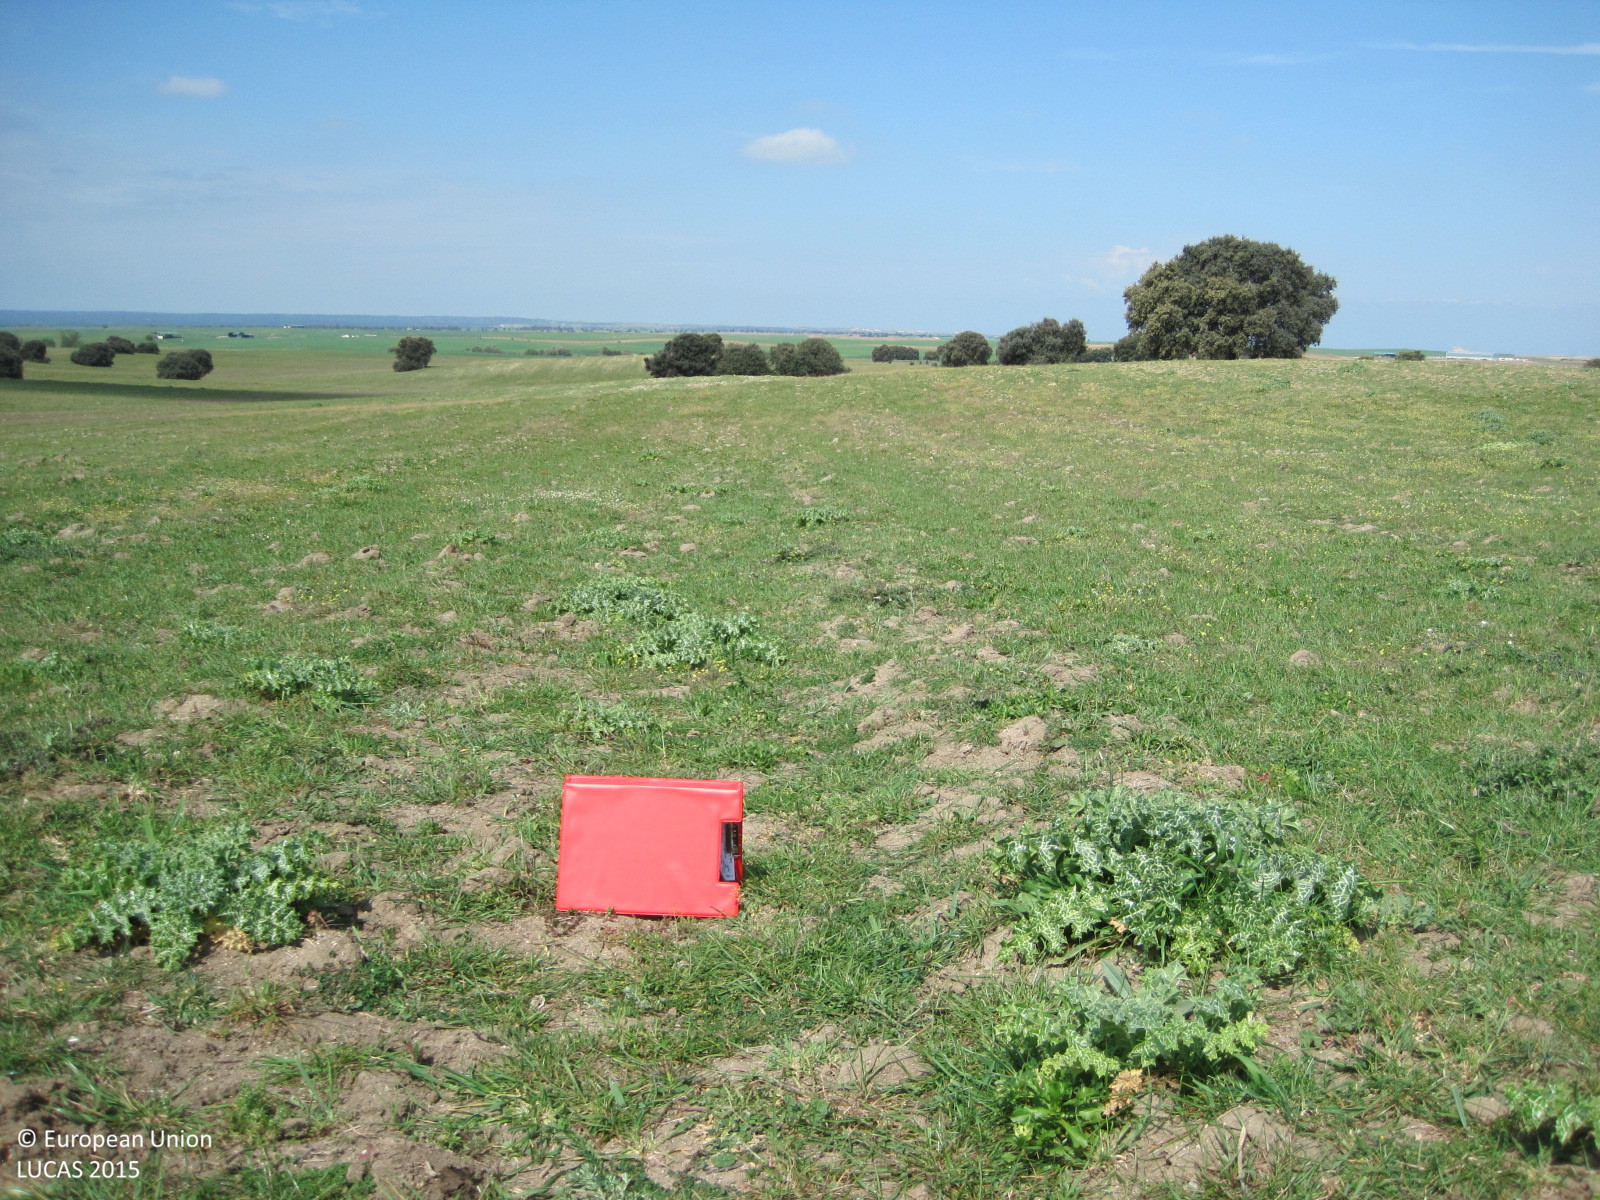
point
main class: Grassland
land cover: Grassland without tree/shrub cover
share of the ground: > 75 %
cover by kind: herbaceous plants 90 %, unconsolidated bare surface 10 %
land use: Agriculture (excluding fallow land and kitchen gardens)
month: April
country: ES
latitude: 39.8527
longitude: -5.0456
